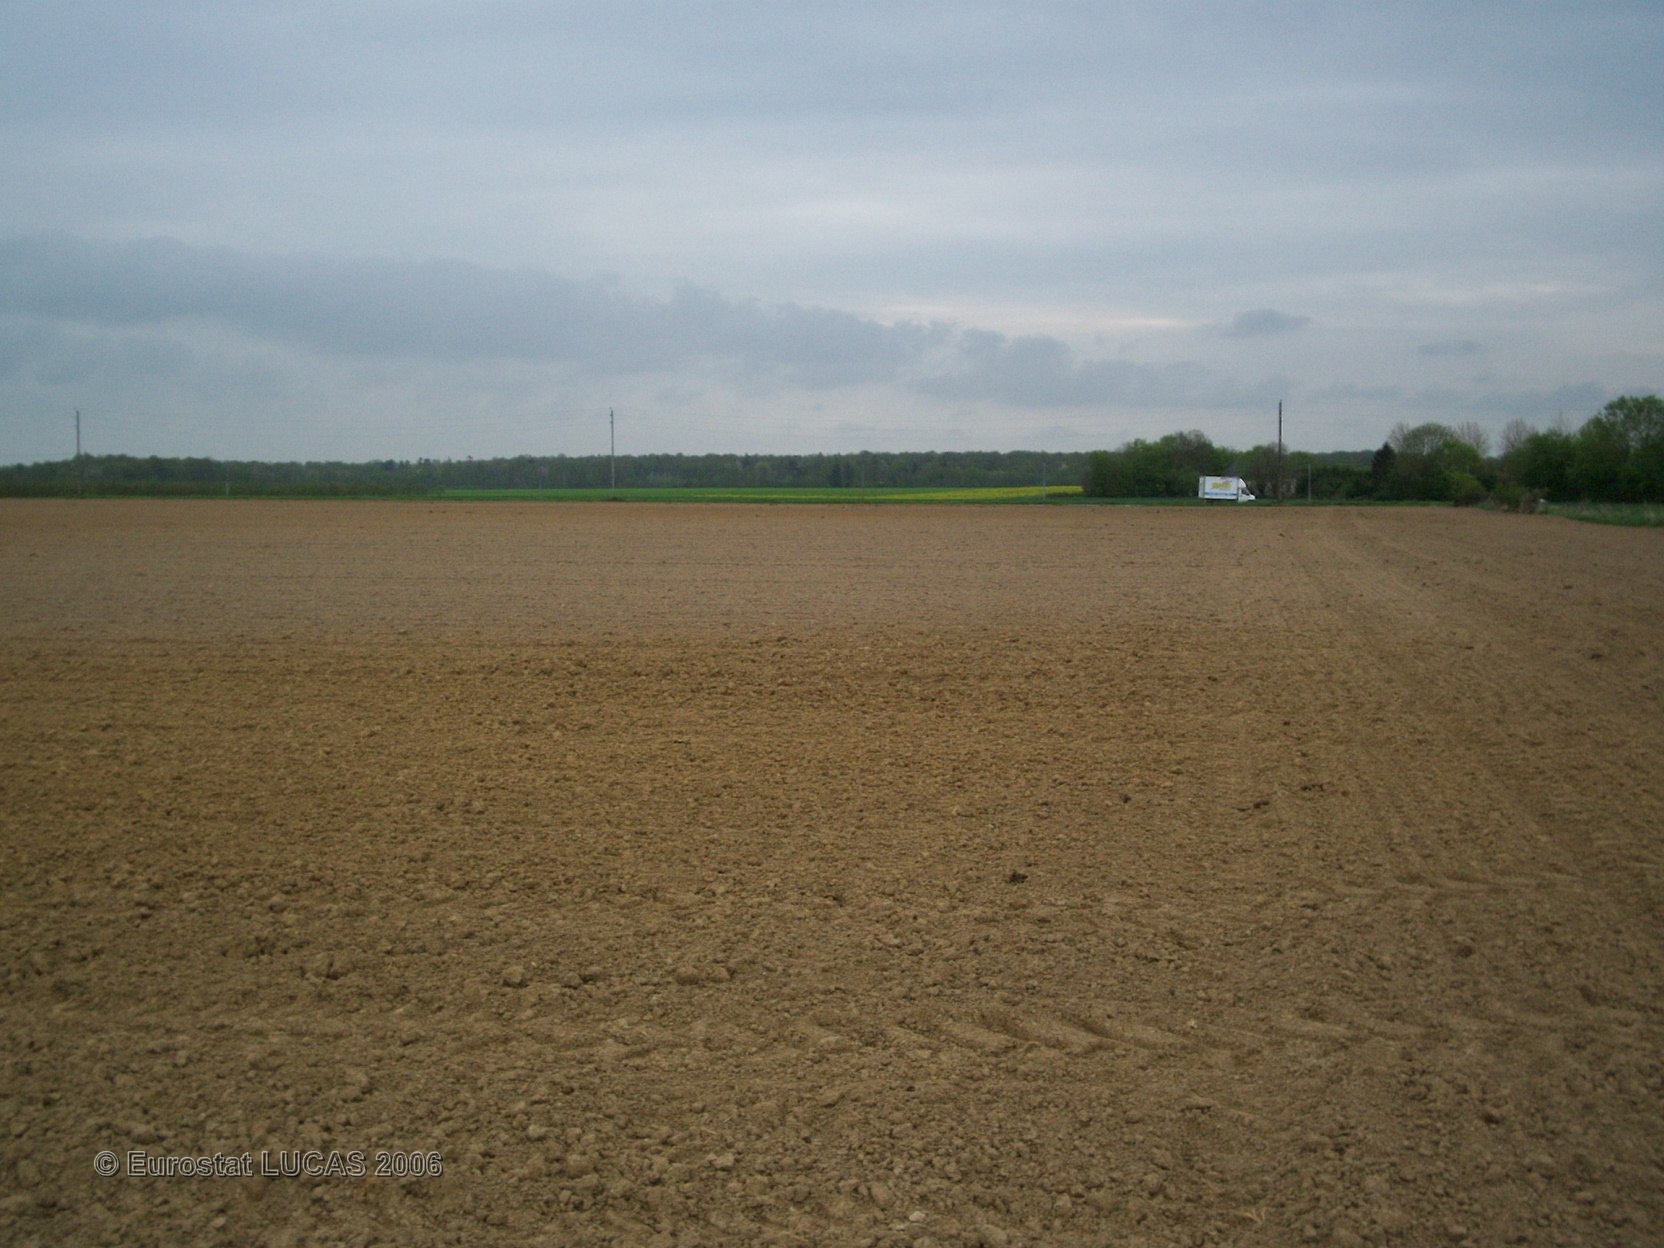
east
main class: Cropland
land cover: Maize
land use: Agriculture (excluding fallow land and kitchen gardens)
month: May
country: FR
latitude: 48.9615
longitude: 0.5917
